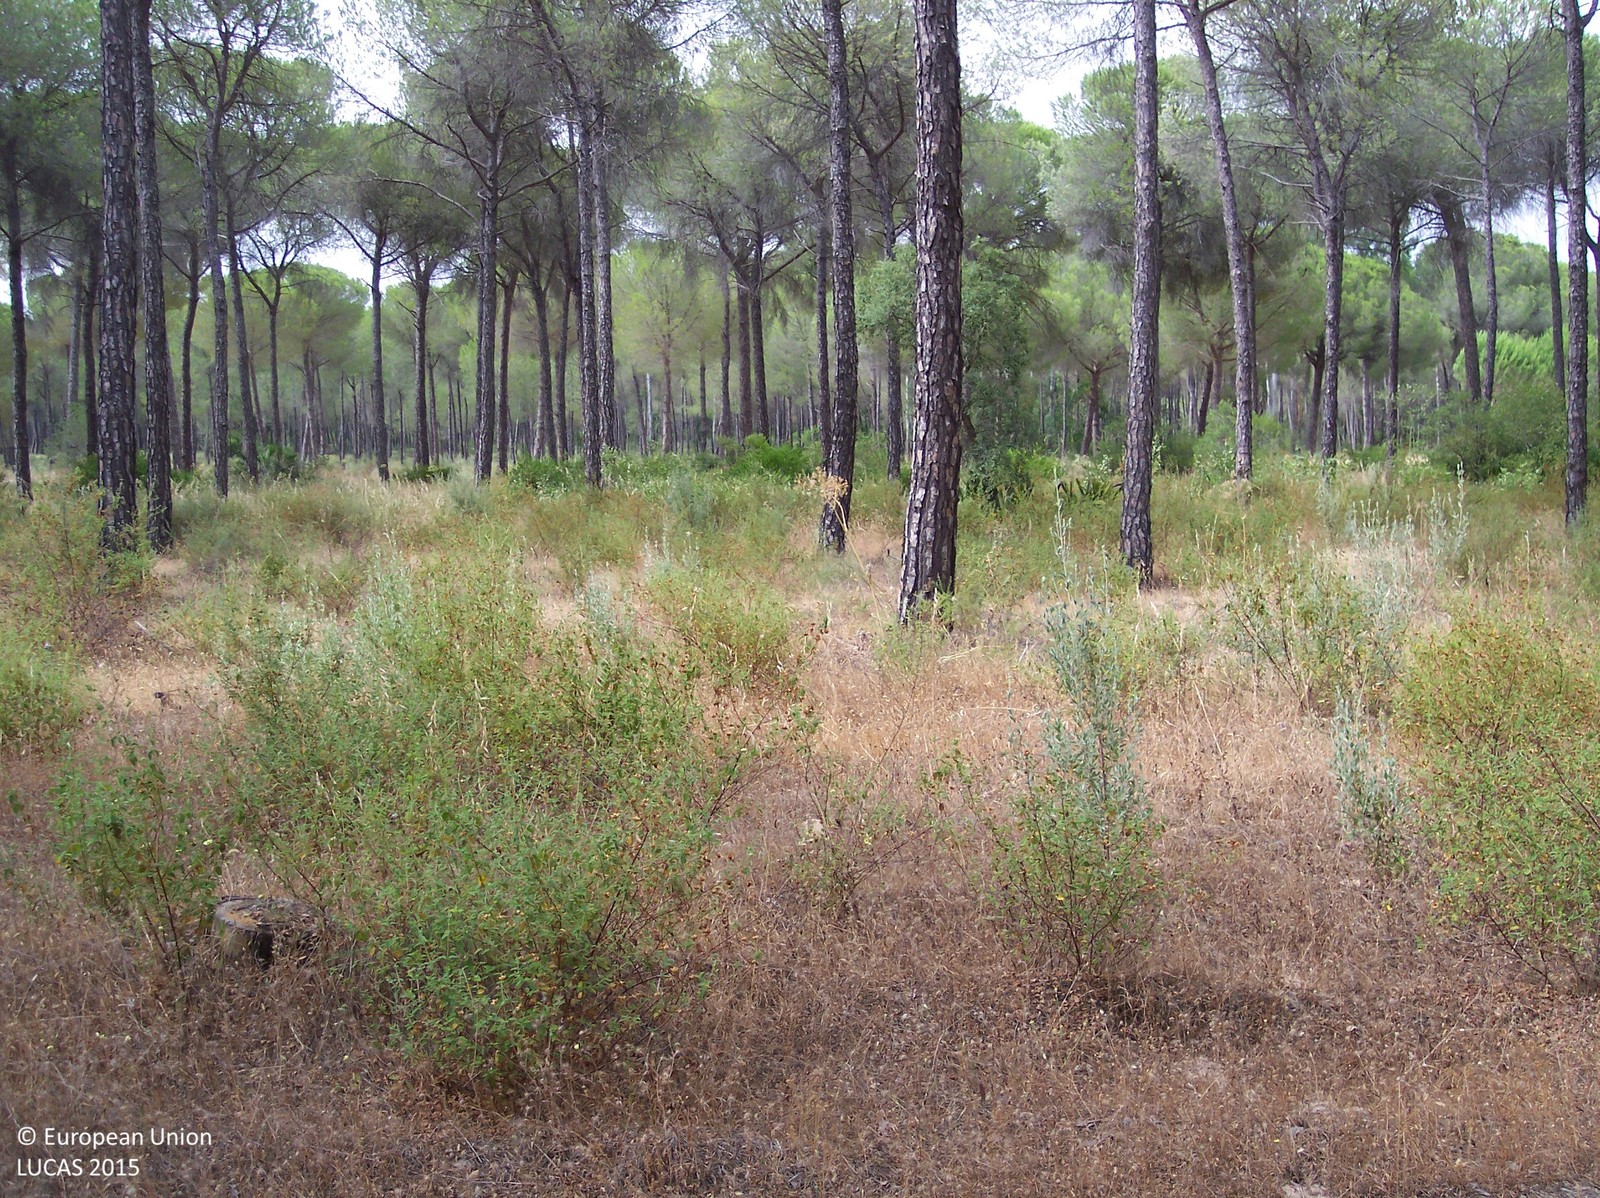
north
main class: Woodland
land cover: Pine dominated coniferous woodland
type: coniferous forest of the mediterranean region
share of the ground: > 75 %
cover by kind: coniferous forest trees 80 %, unconsolidated bare surface 10 %, shrubs 5 %, herbaceous plants 5 %
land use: Forestry
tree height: > 5 m
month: June
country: ES
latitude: 37.2842
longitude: -6.4405
